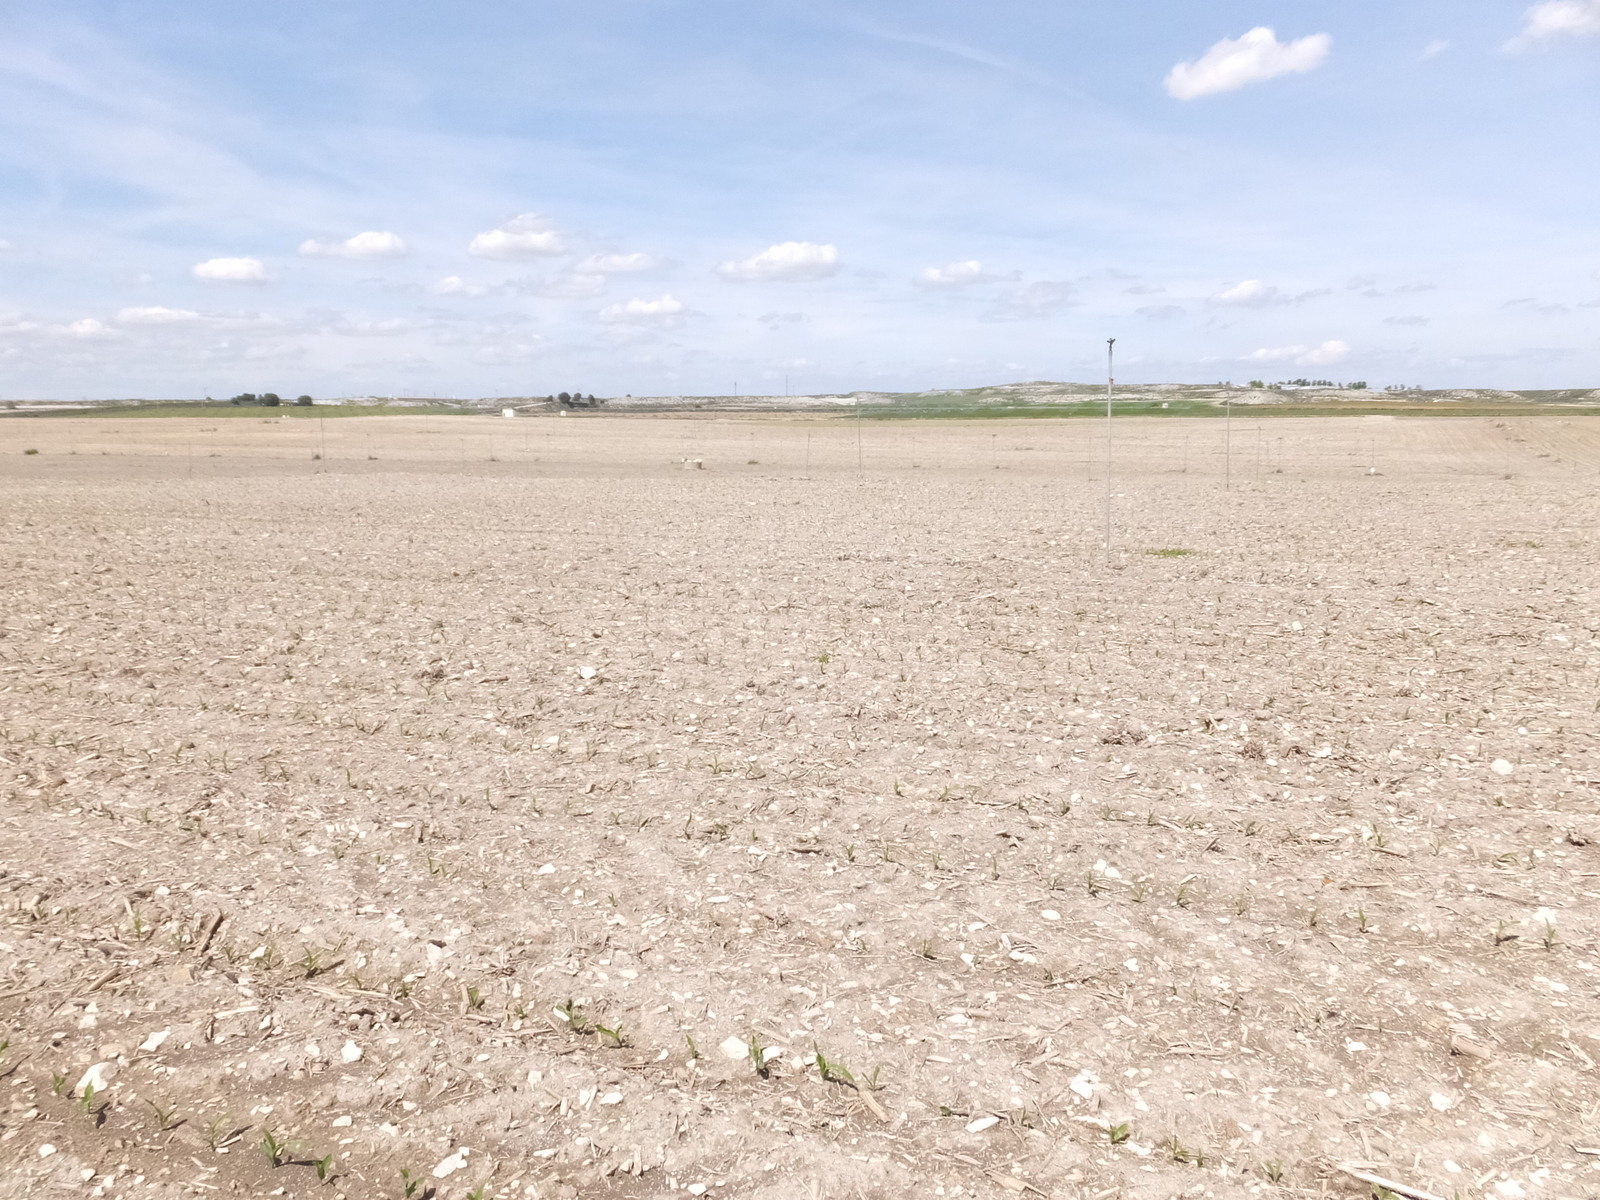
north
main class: Cropland
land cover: Maize
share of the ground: < 10 %
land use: Agriculture (excluding fallow land and kitchen gardens)
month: April
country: ES
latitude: 41.5072
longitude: -0.1392
